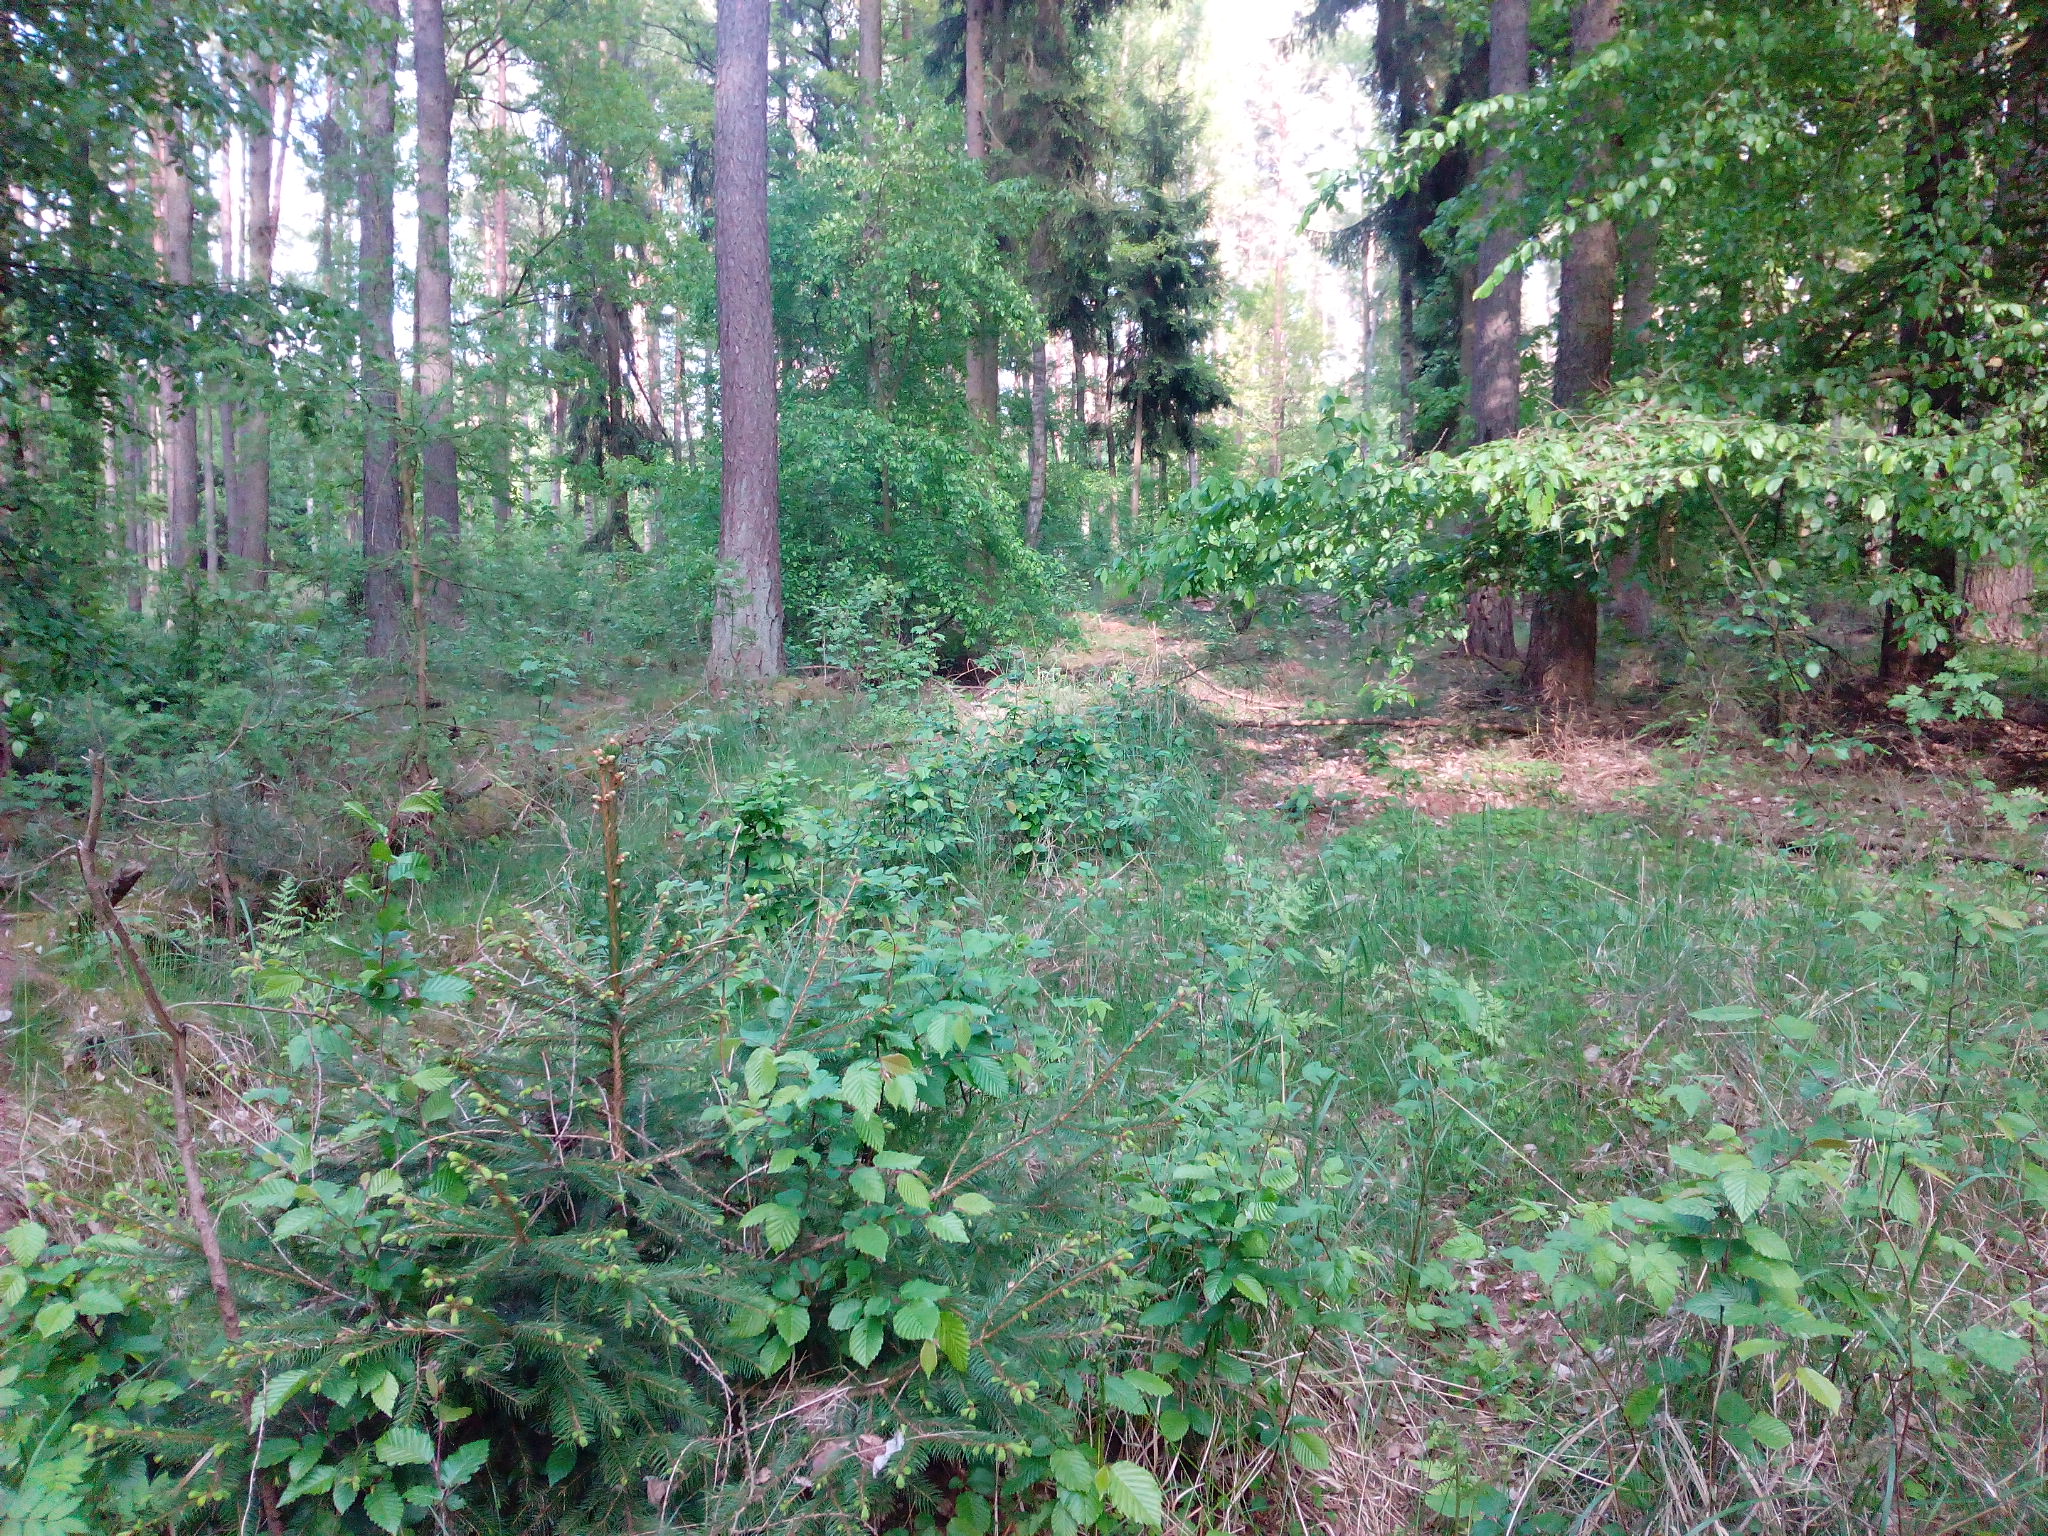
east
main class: Woodland
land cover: Other mixed woodland
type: hemiboreal forest and nemoral coniferous forest and mixed broadleaved-coniferous forest
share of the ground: 25 - 50 %
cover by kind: coniferous forest trees 30 %, broadleaved forest trees 25 %, herbaceous plants 25 %, lichens and mosses 20 %
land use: Forestry
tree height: > 5 m
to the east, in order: Other mixed woodland; Tracks; Pine dominated mixed woodland; Tracks; Pine dominated mixed woodland; Tracks
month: May
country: DE
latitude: 52.9360
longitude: 13.5561
